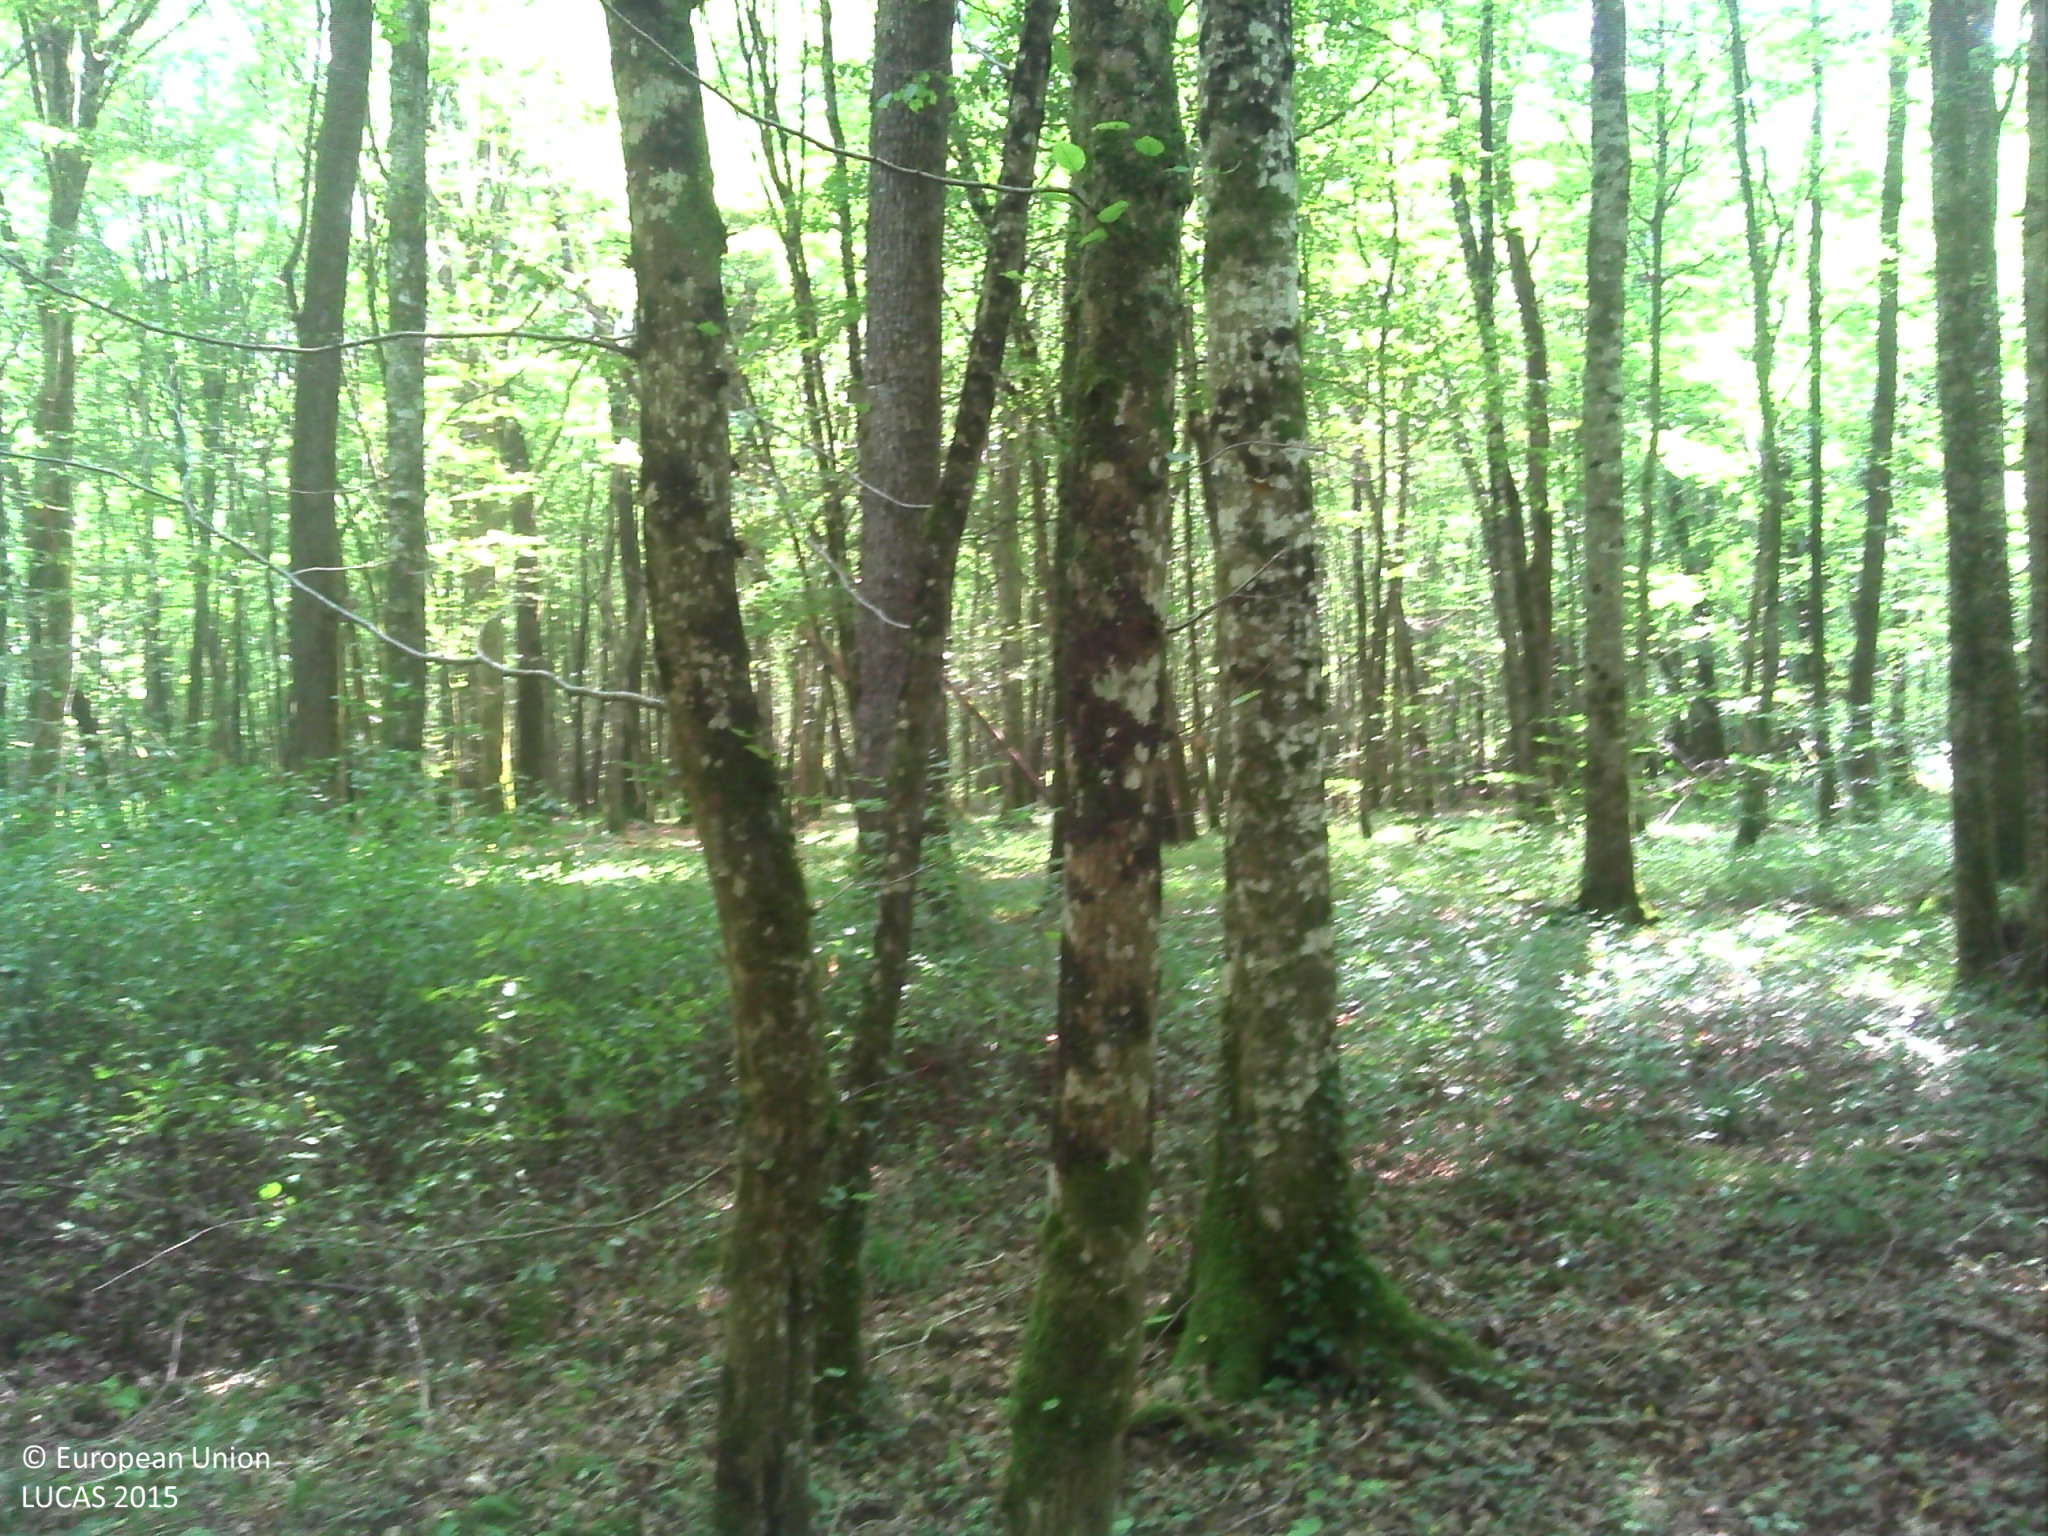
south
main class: Woodland
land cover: Broadleaved woodland
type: acidophilous oak and oak-birch forest
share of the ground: > 75 %
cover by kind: broadleaved forest trees 85 %, herbaceous plants 10 %, lichens and mosses 5 %
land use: Forestry
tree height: > 5 m
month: July
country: FR
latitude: 47.9828
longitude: 4.9748
